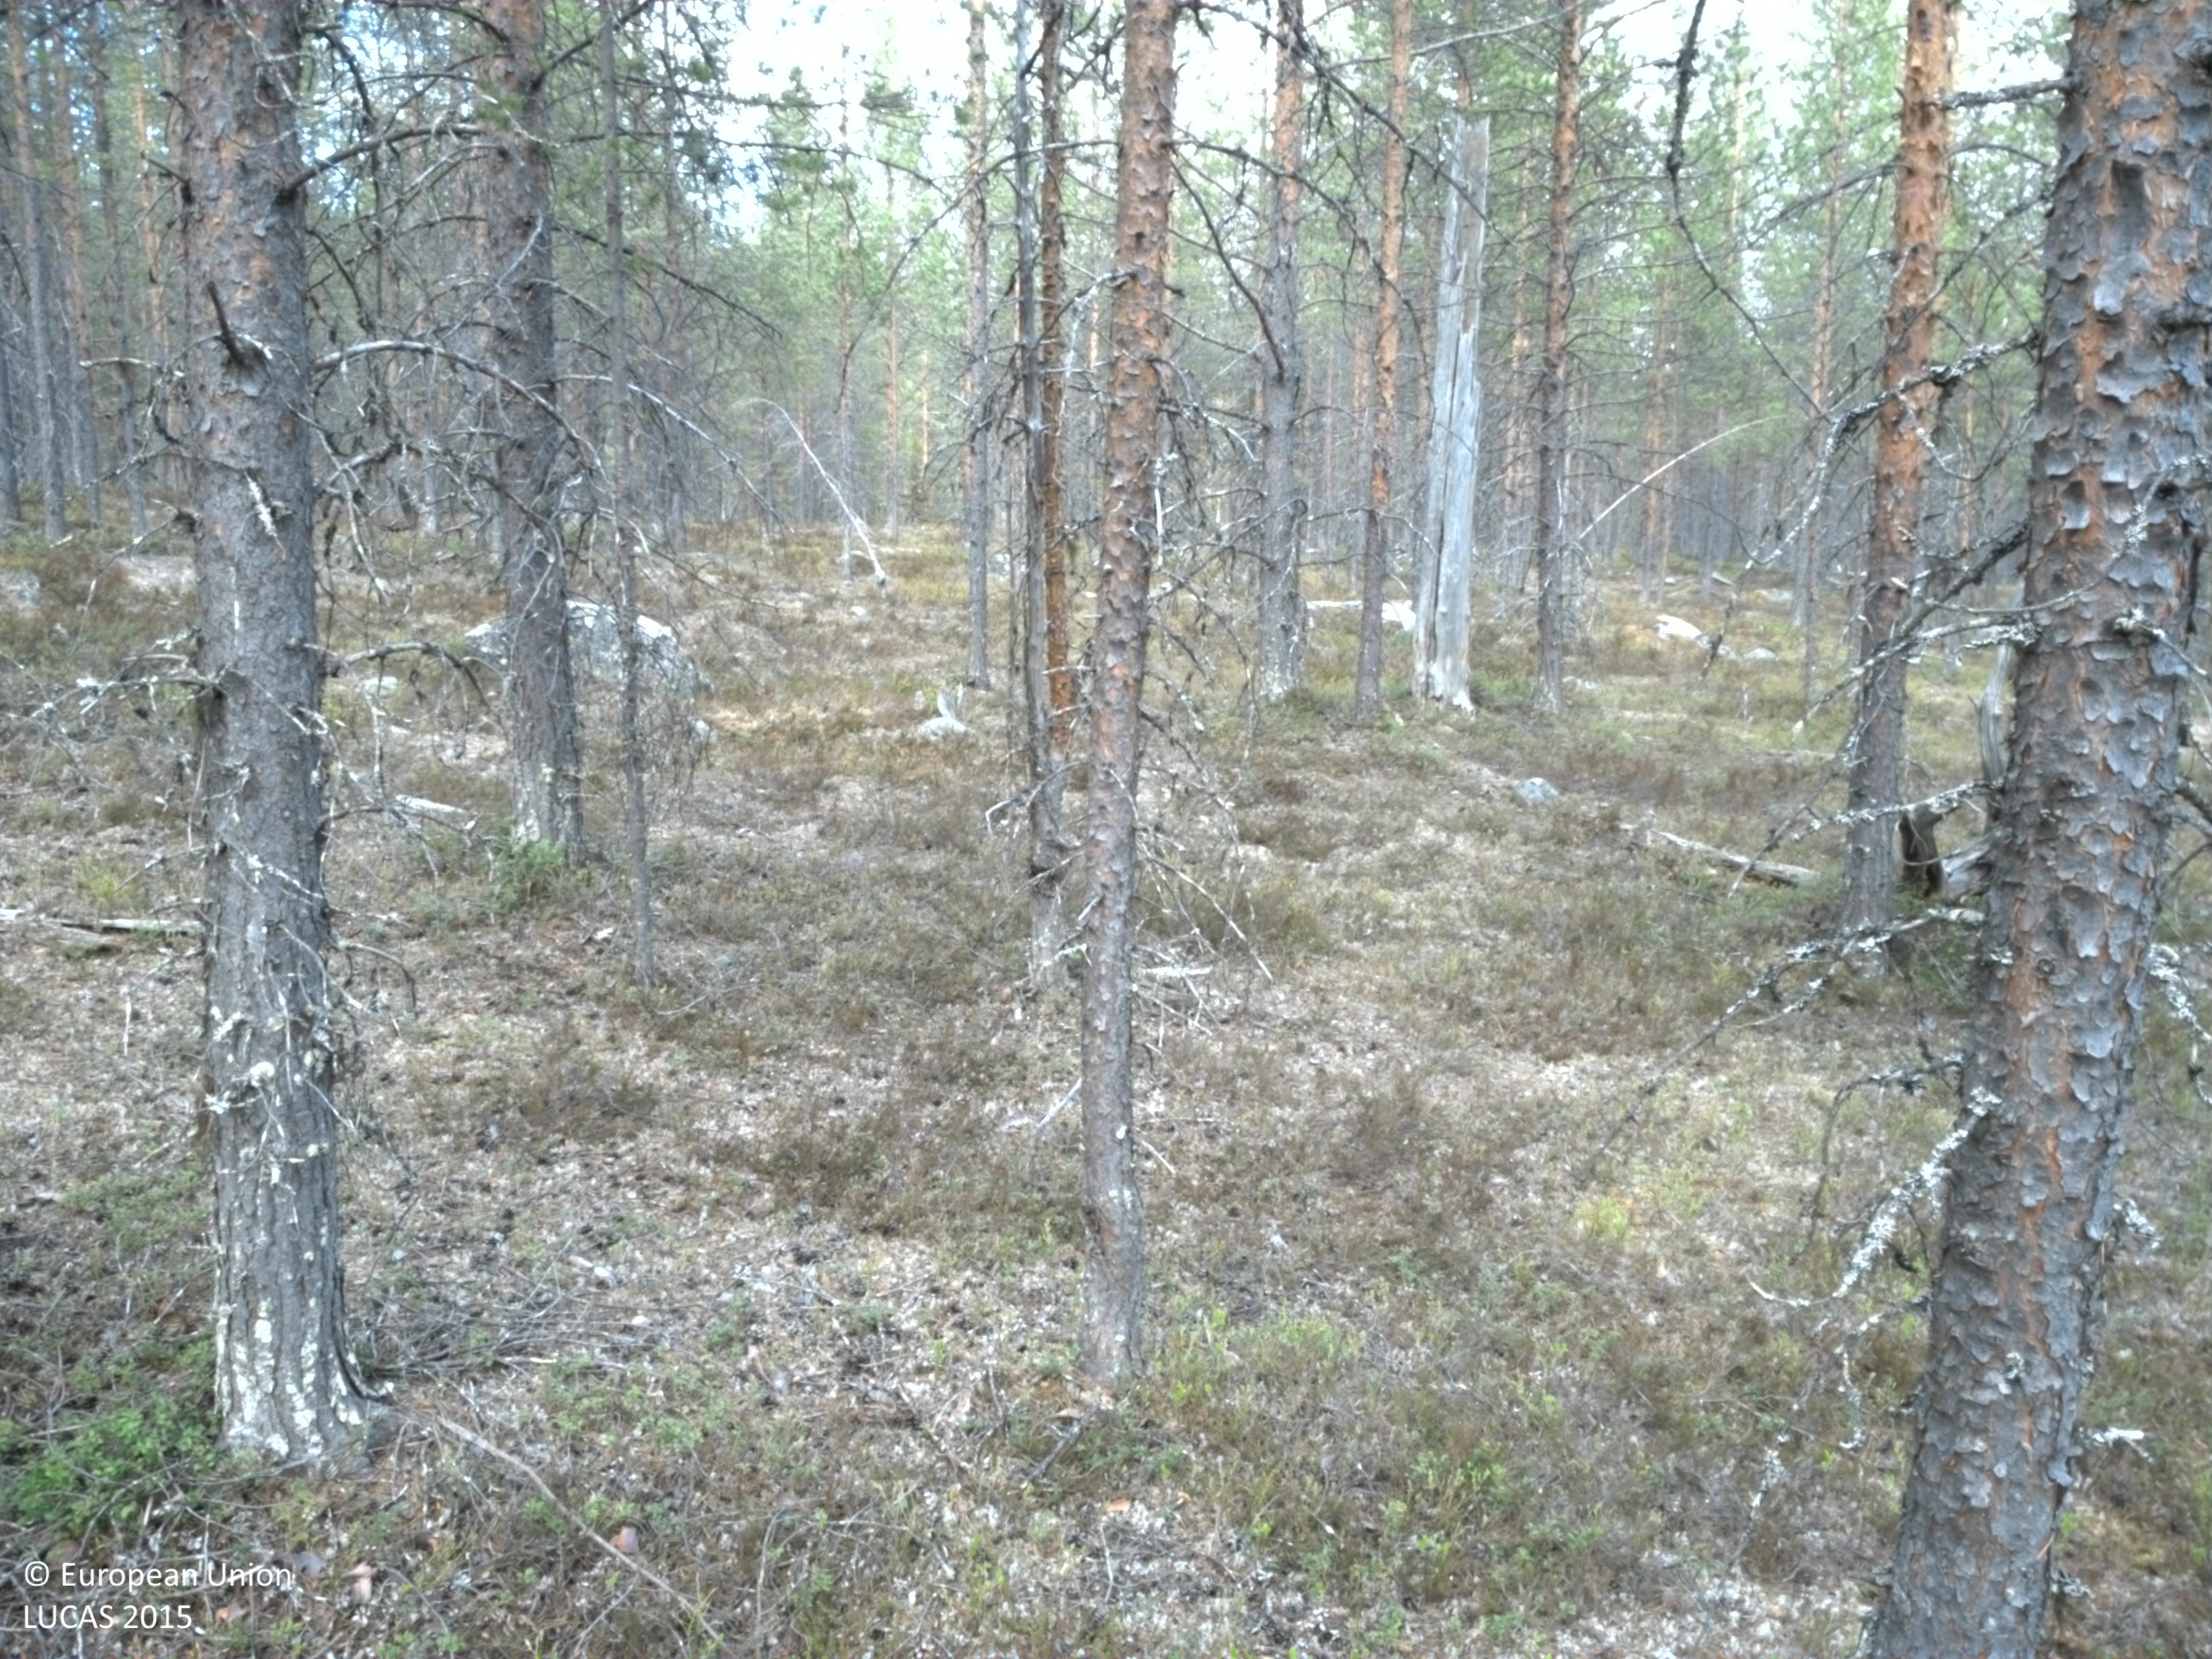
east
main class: Woodland
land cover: Pine dominated coniferous woodland
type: boreal forest
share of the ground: 25 - 50 %
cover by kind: shrubs 50 %, coniferous forest trees 40 %, lichens and mosses 5 %, consolidated bare surface 5 %
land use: Forestry
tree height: > 5 m
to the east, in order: Pine dominated coniferous woodland
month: June
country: SE
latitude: 65.8988
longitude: 19.5052
